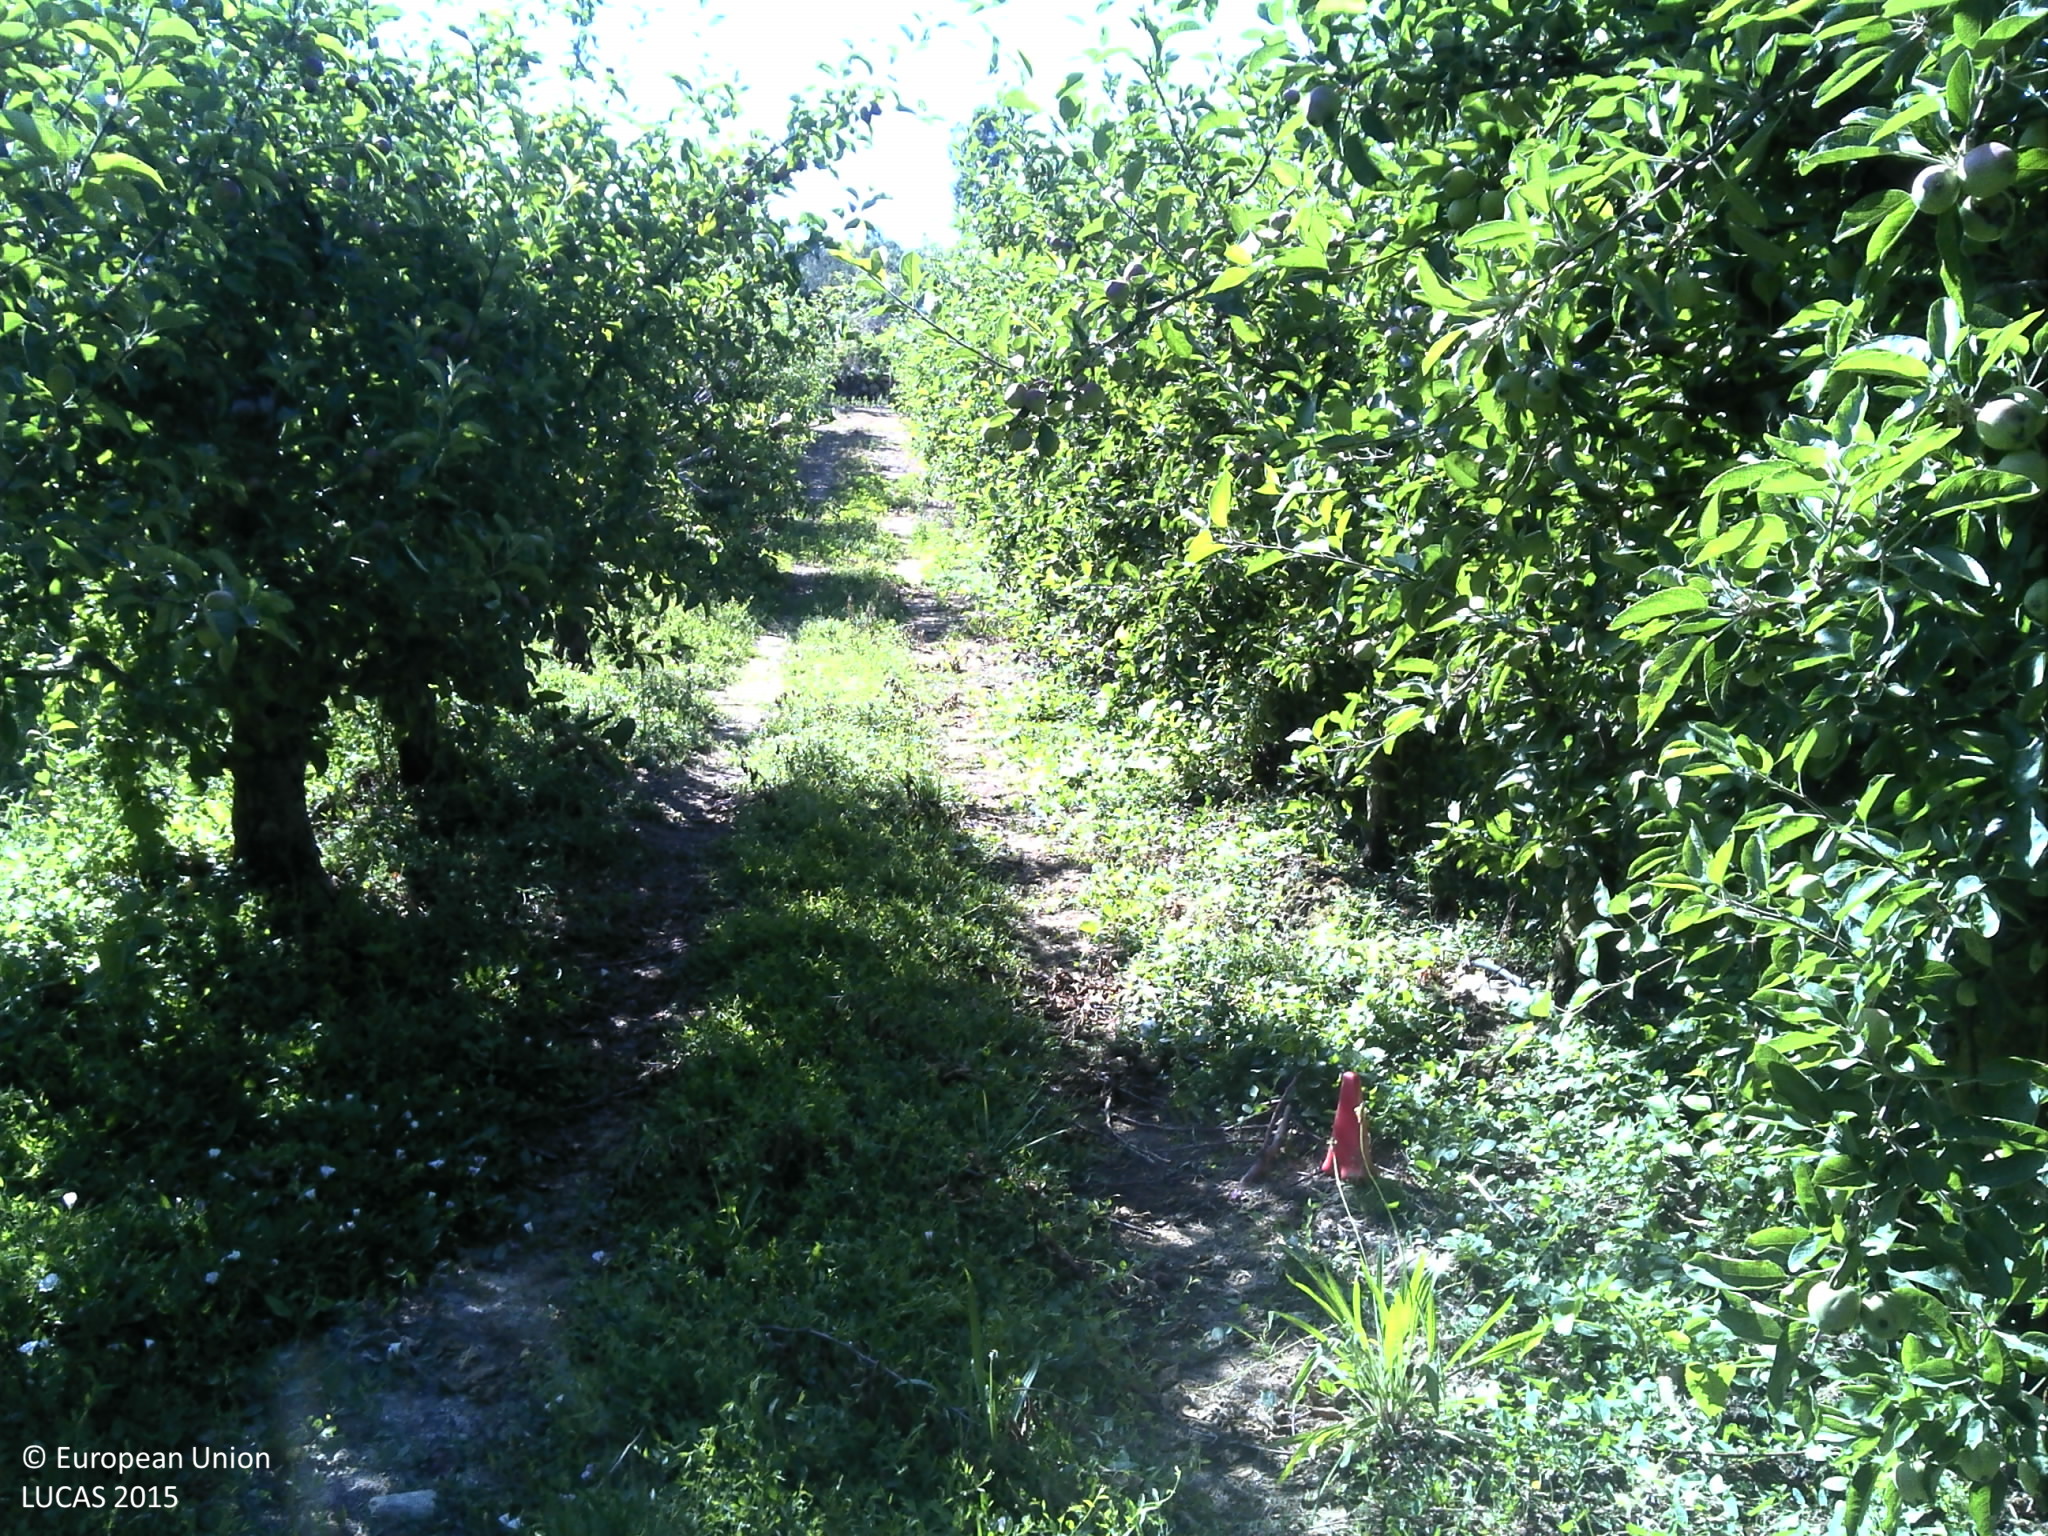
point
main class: Cropland
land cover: Apple fruit
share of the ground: 50 - 75 %
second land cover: Grassland without tree/shrub cover
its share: 25 - 50 %
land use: Agriculture (excluding fallow land and kitchen gardens)
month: June
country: PT
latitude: 40.9950
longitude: -7.5598
